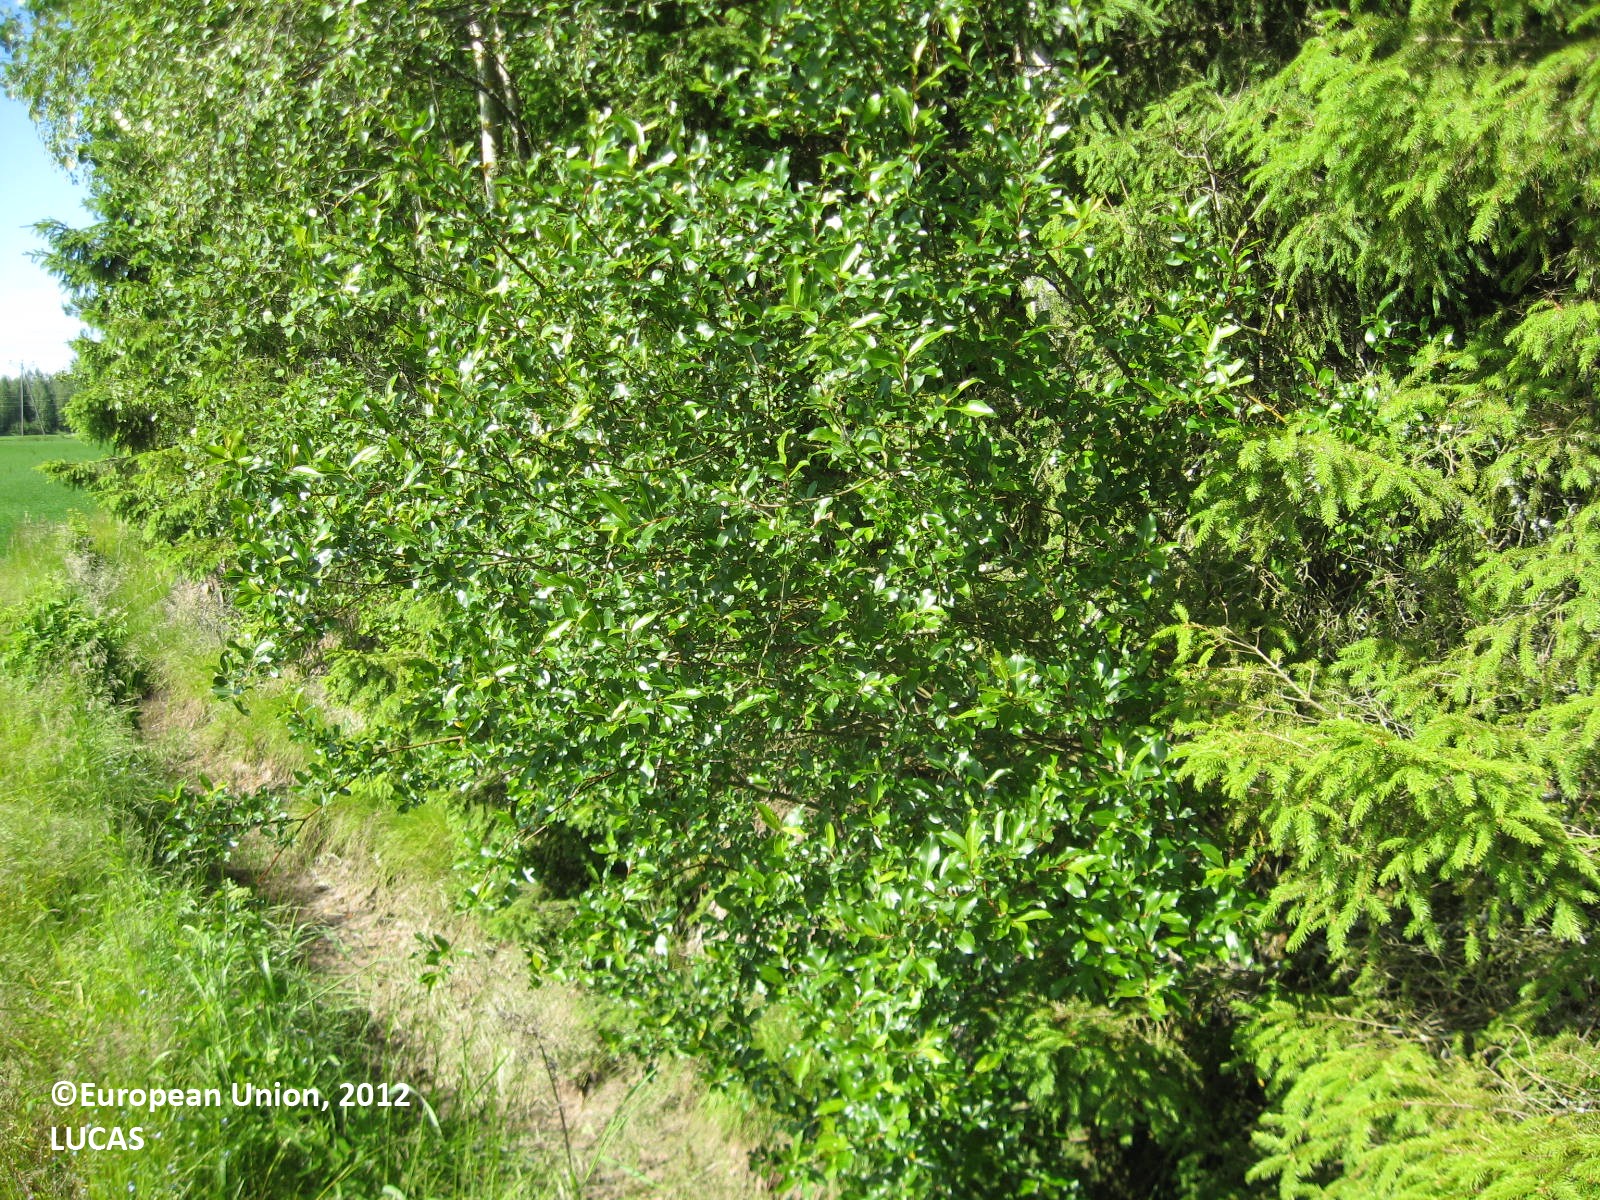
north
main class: Cropland
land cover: Barley
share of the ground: > 75 %
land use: Agriculture (excluding fallow land and kitchen gardens)
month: June
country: FI
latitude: 62.8248
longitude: 22.6751
